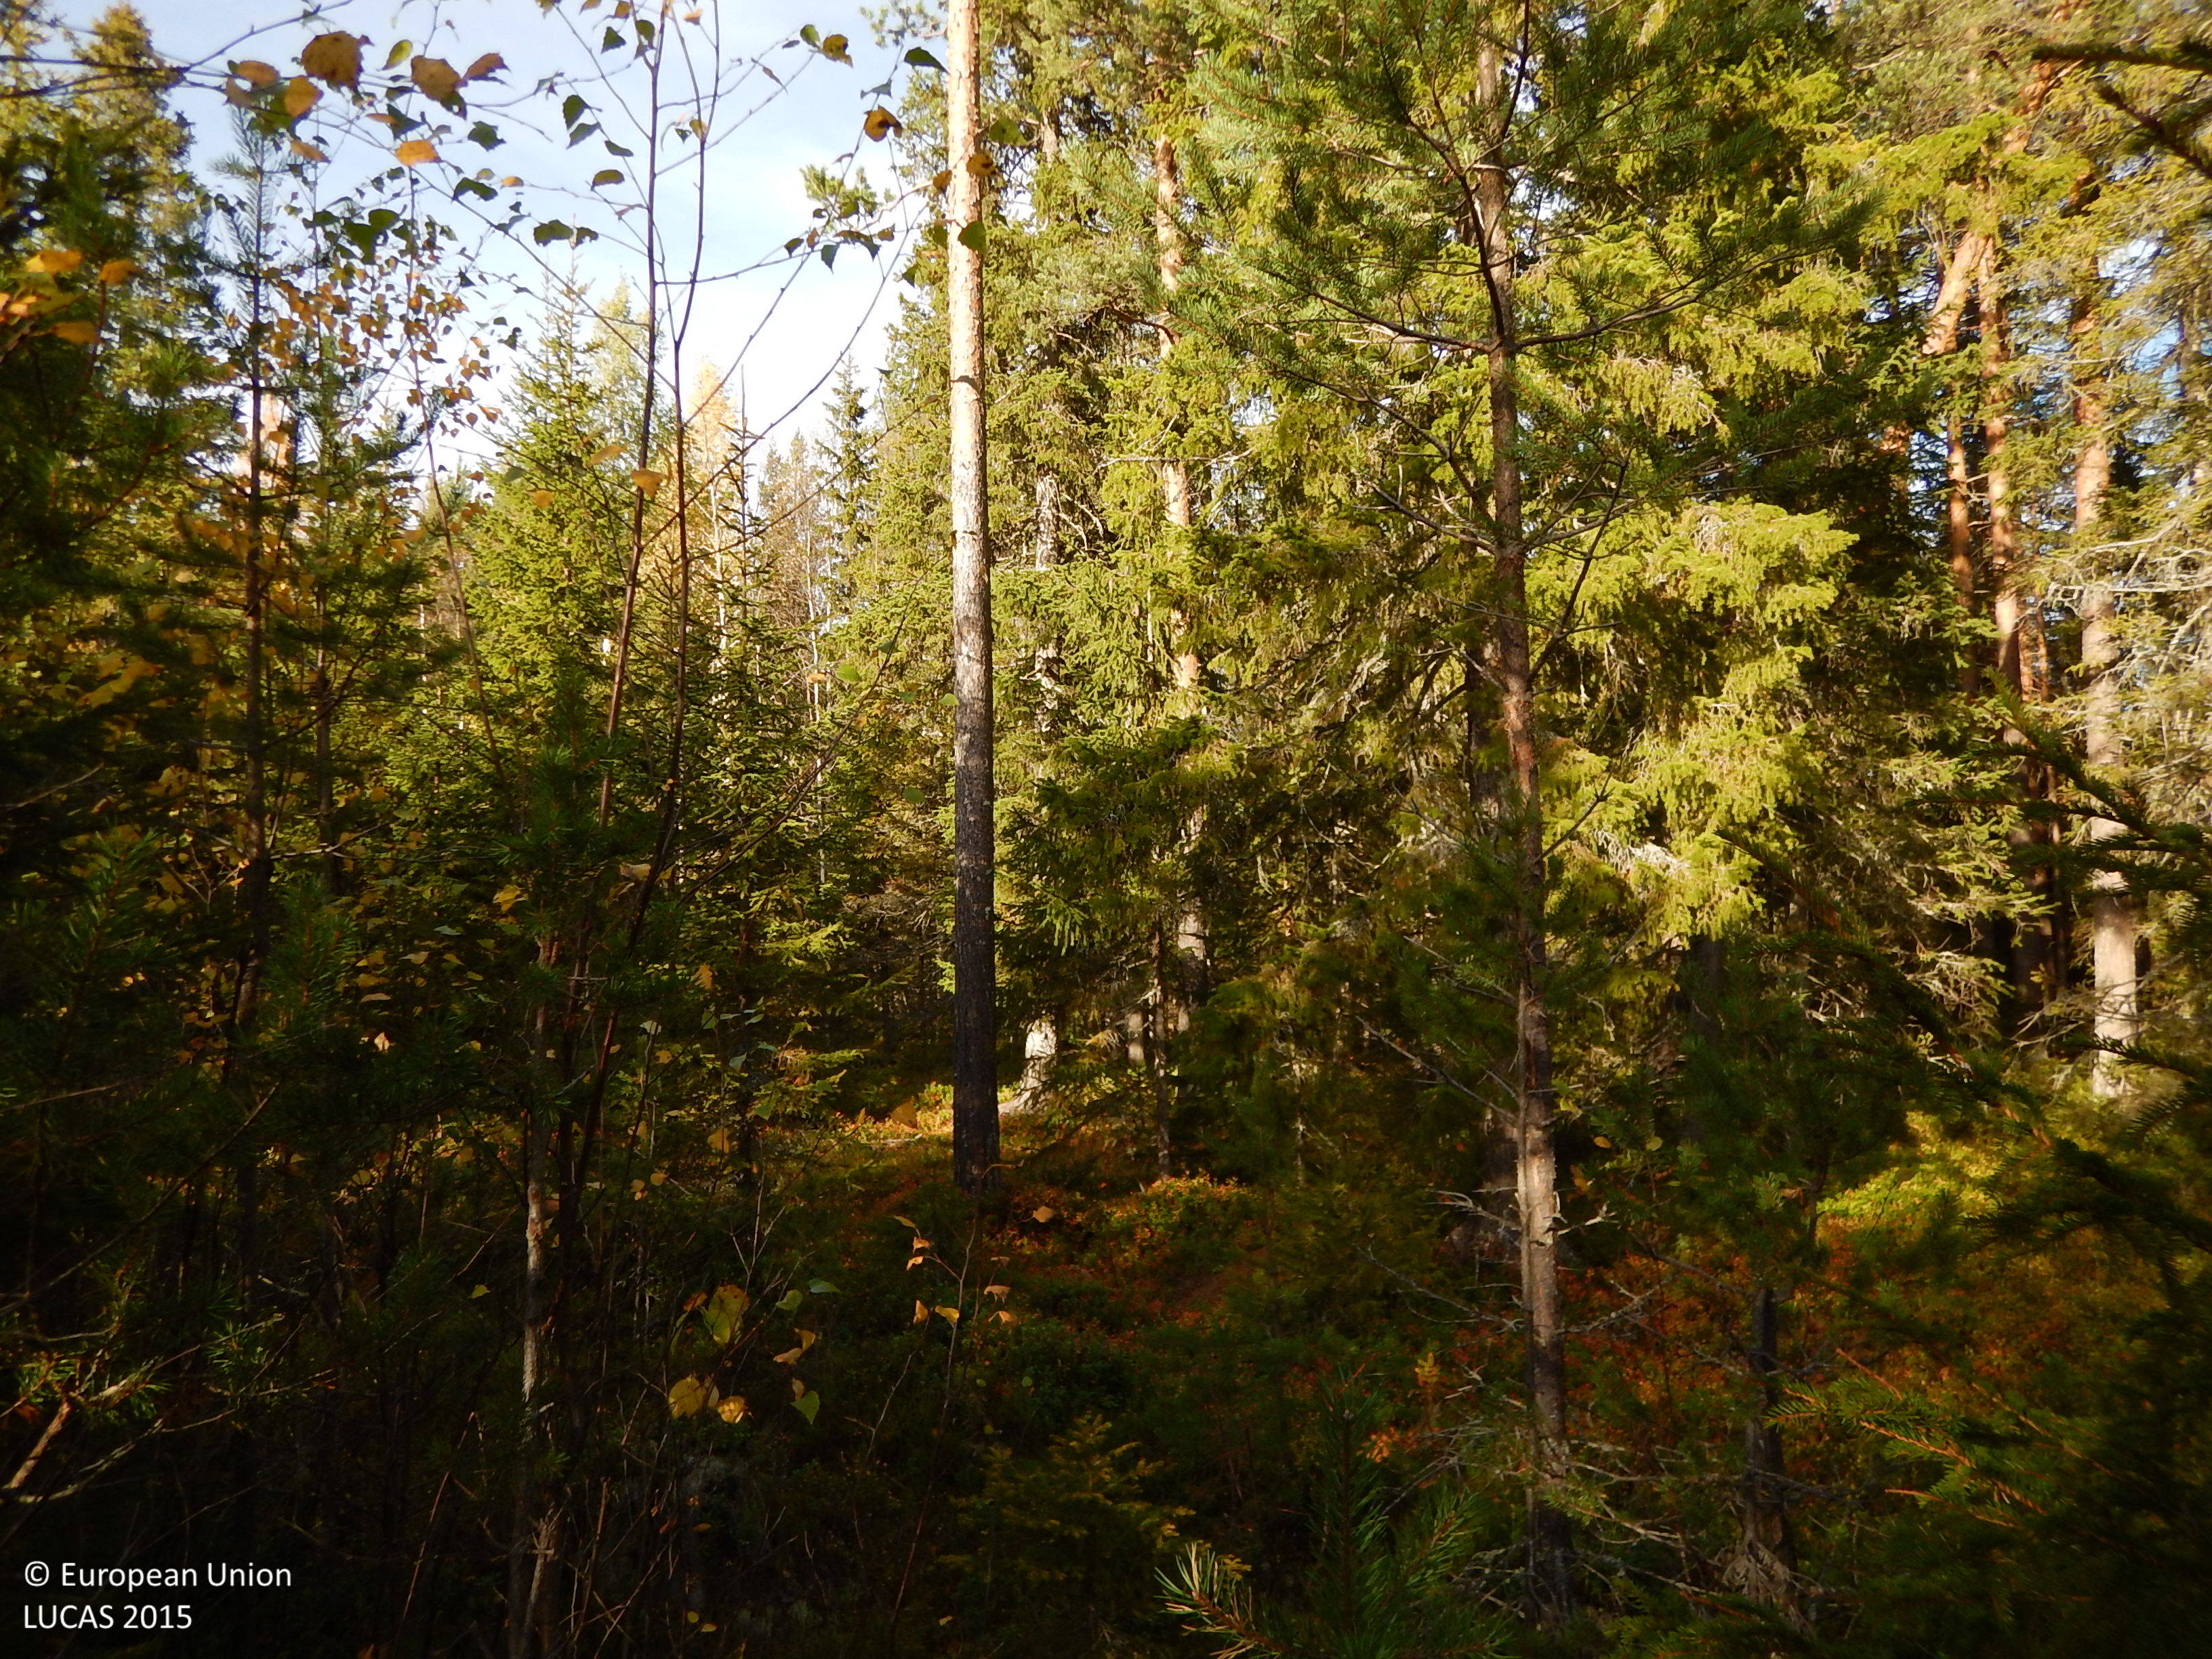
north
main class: Woodland
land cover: Other mixed woodland
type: boreal forest
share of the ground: > 75 %
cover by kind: coniferous forest trees 50 %, broadleaved forest trees 25 %, shrubs 10 %, herbaceous plants 10 %, lichens and mosses 5 %
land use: Forestry
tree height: > 5 m
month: October
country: SE
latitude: 64.9223
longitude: 20.8227
